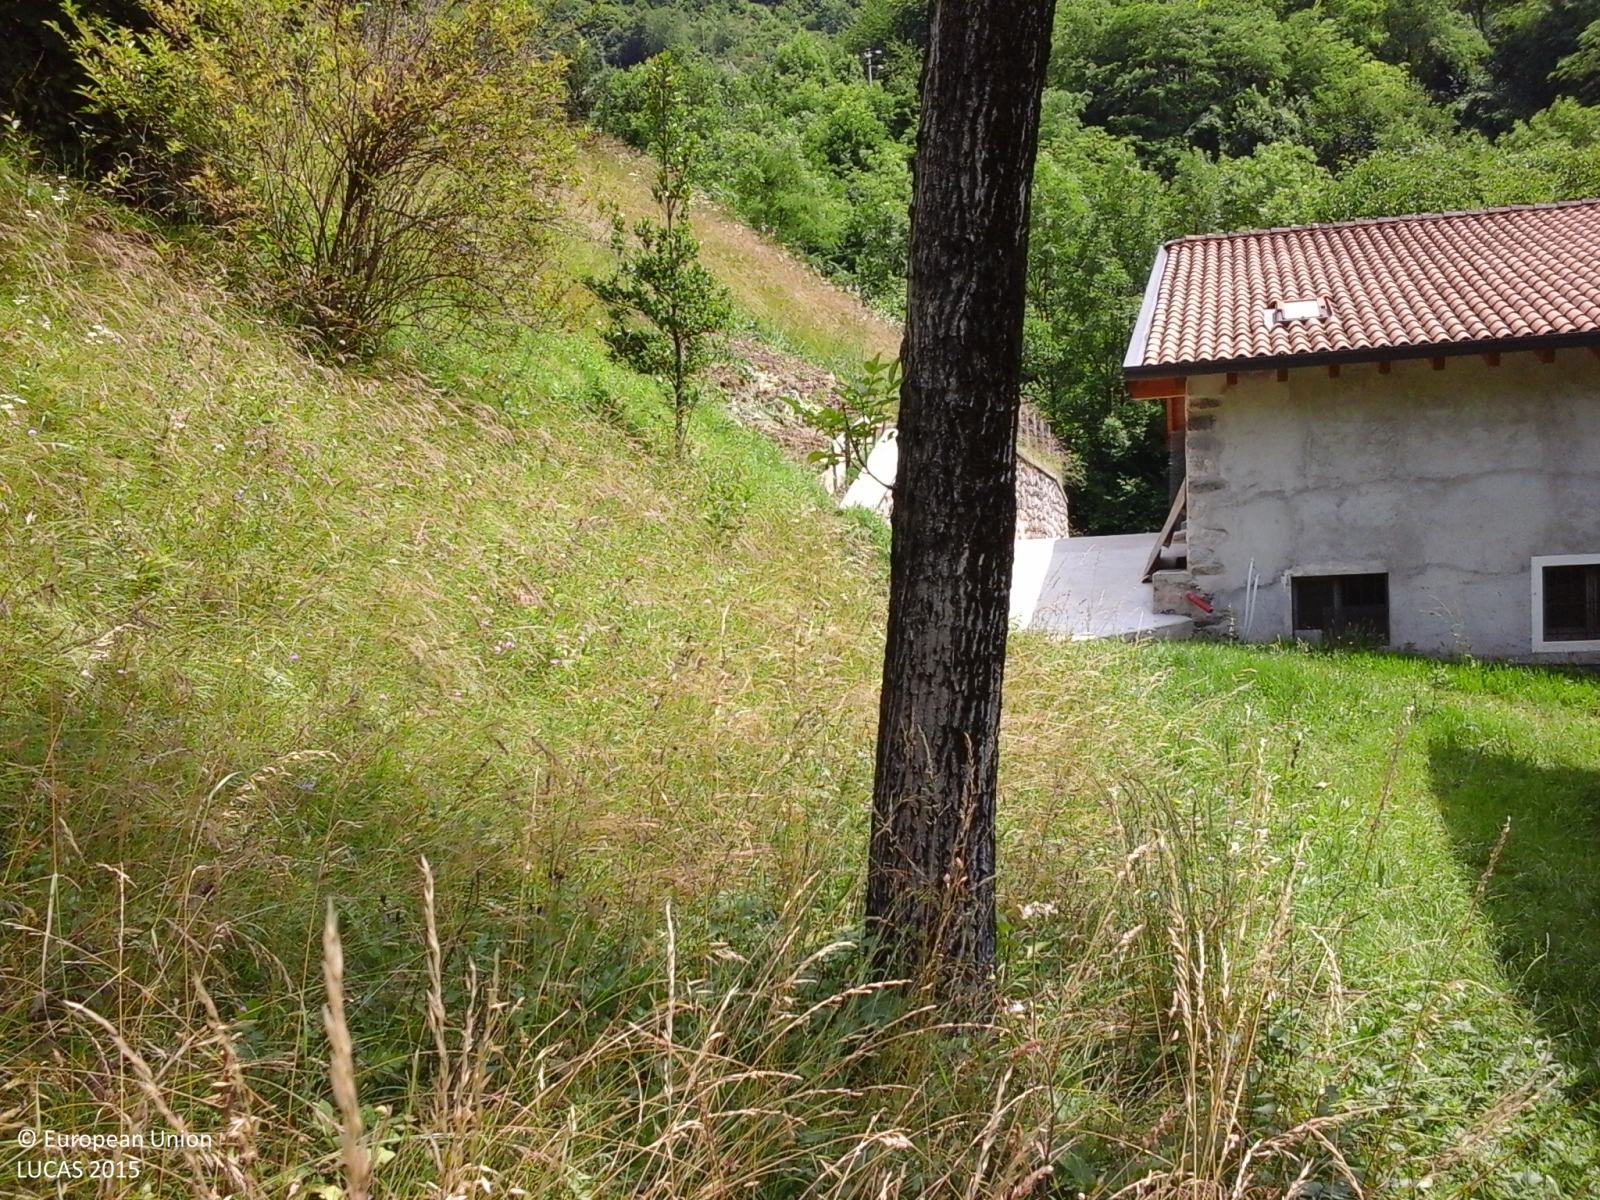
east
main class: Grassland
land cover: Grassland with sparse tree/shrub cover
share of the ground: > 75 %
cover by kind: herbaceous plants 95 %, broadleaved forest trees 5 %
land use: Agriculture (excluding fallow land and kitchen gardens)
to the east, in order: Grassland with sparse tree/shrub cover; Broadleaved woodland; Tracks; Broadleaved woodland; Ditches and canals; Broadleaved woodland; Tracks; Broadleaved woodland; Grassland with sparse tree/shrub cover; Paved roads, cycling and walking lanes; Grassland without tree/shrub cover
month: June
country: IT
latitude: 45.7566
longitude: 10.1155
